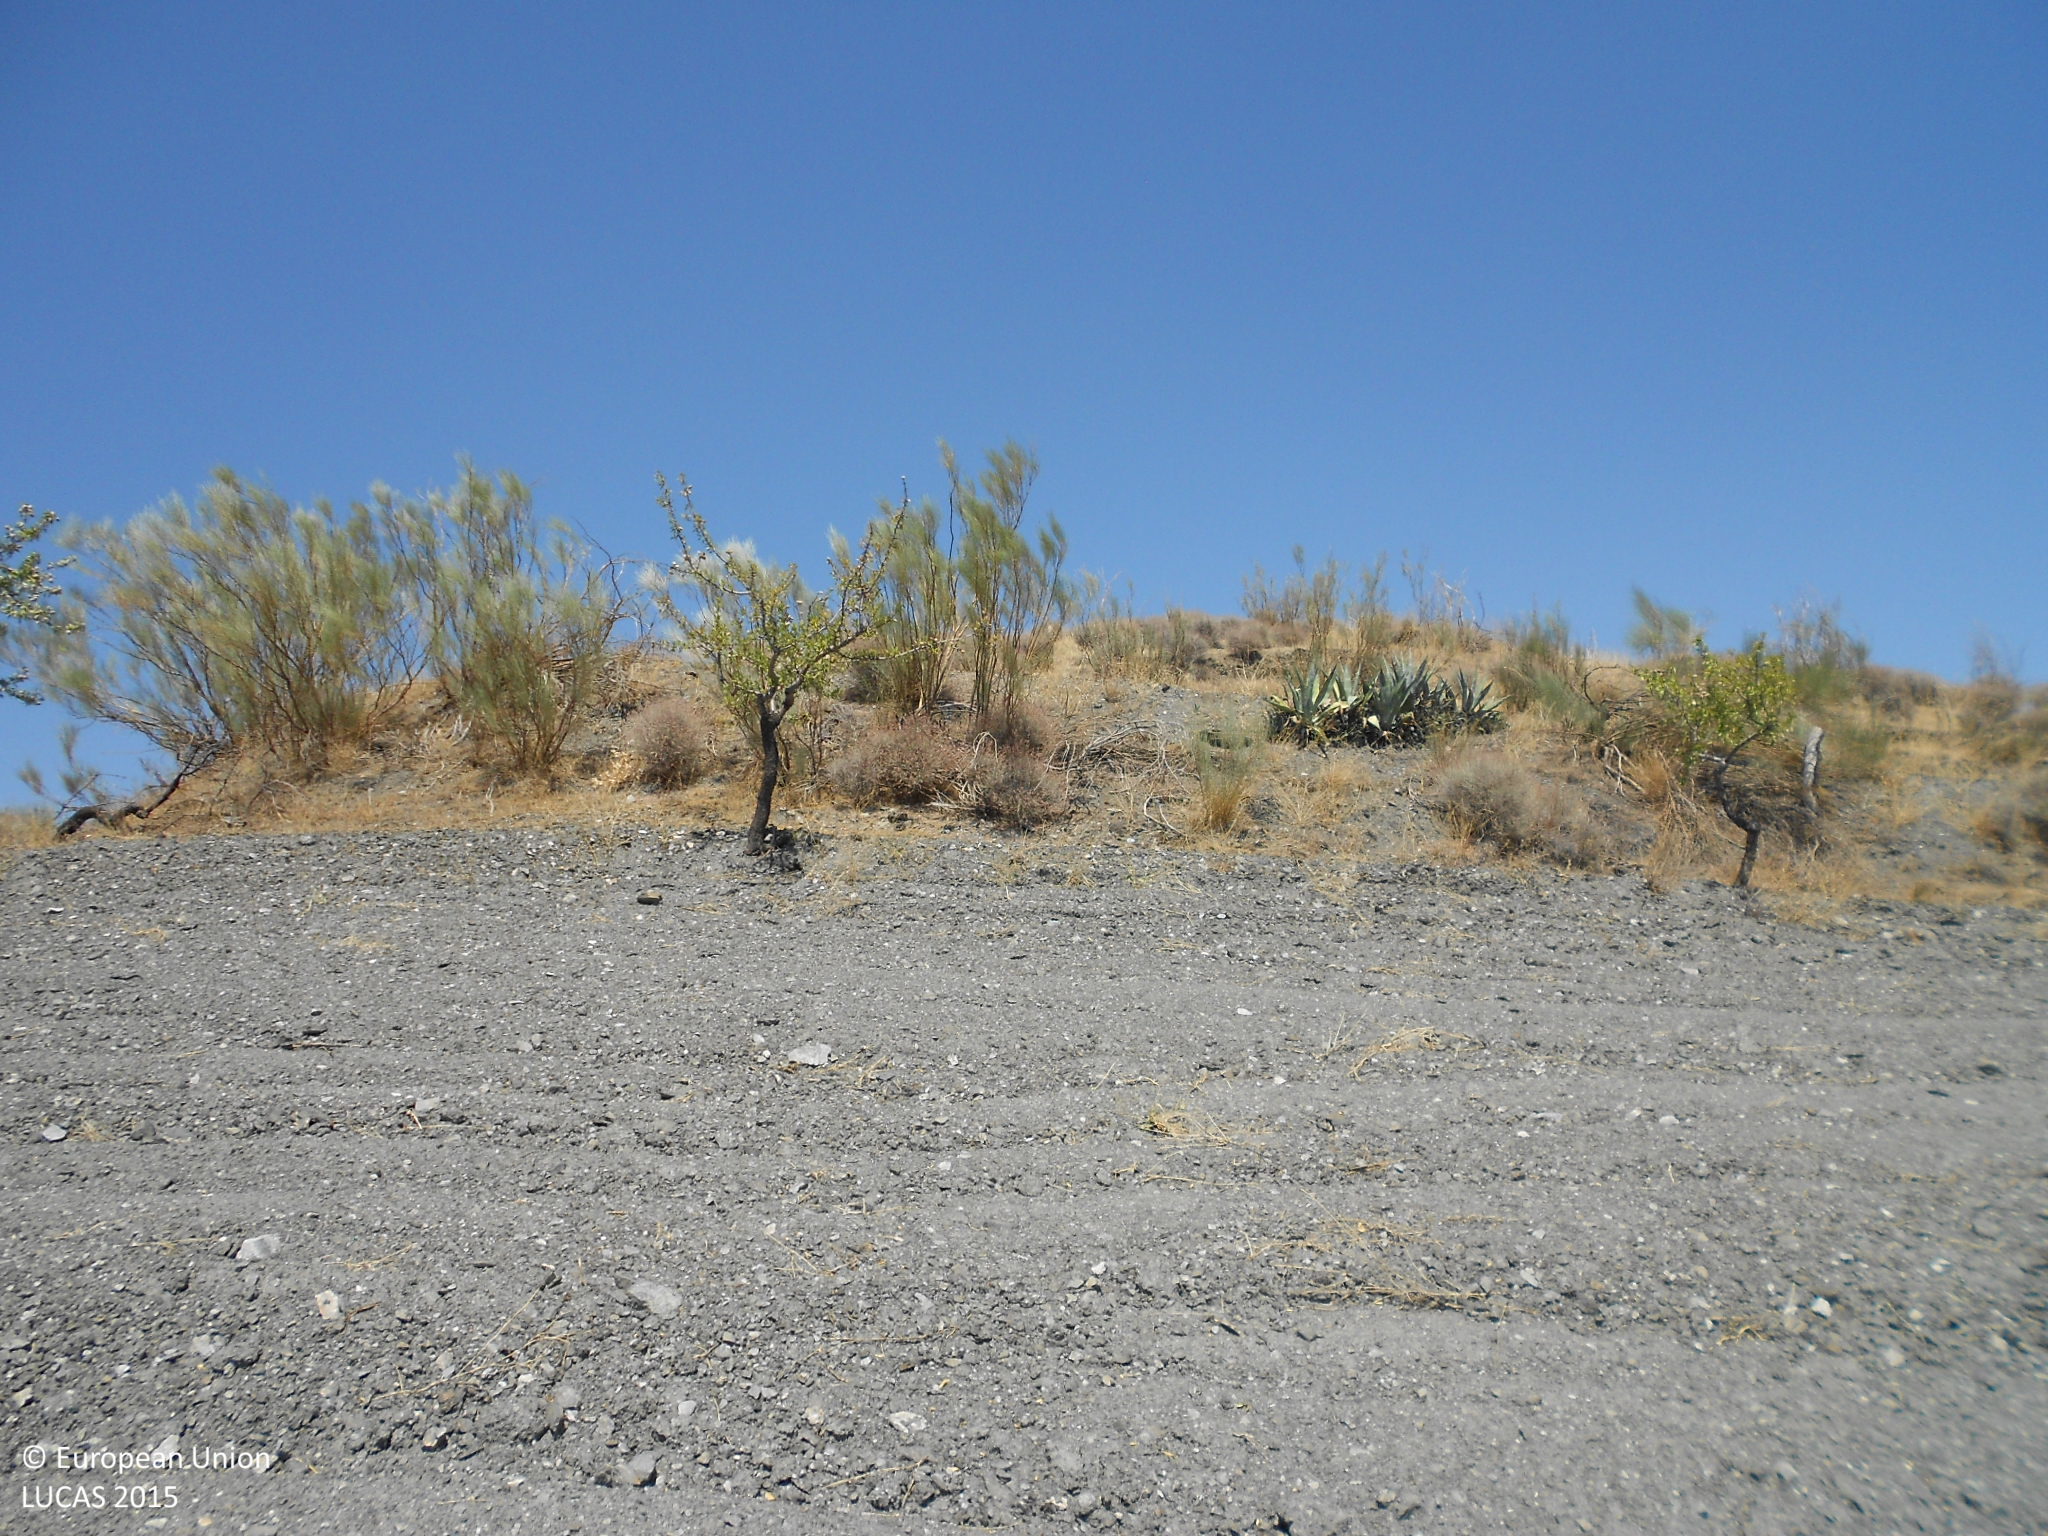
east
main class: Cropland
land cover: Nuts trees
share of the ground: 10 - 25 %
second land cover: Other bare soil
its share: > 75 %
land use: Agriculture (excluding fallow land and kitchen gardens)
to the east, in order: Nuts trees; Other bare soil; Grass margins; Tracks; Shrubland without tree cover; Electric lines; Tracks; Shrubland without tree cover; Paved roads, cycling and walking lanes; Shrubland without tree cover
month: July
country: ES
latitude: 37.4474
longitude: -2.2471
